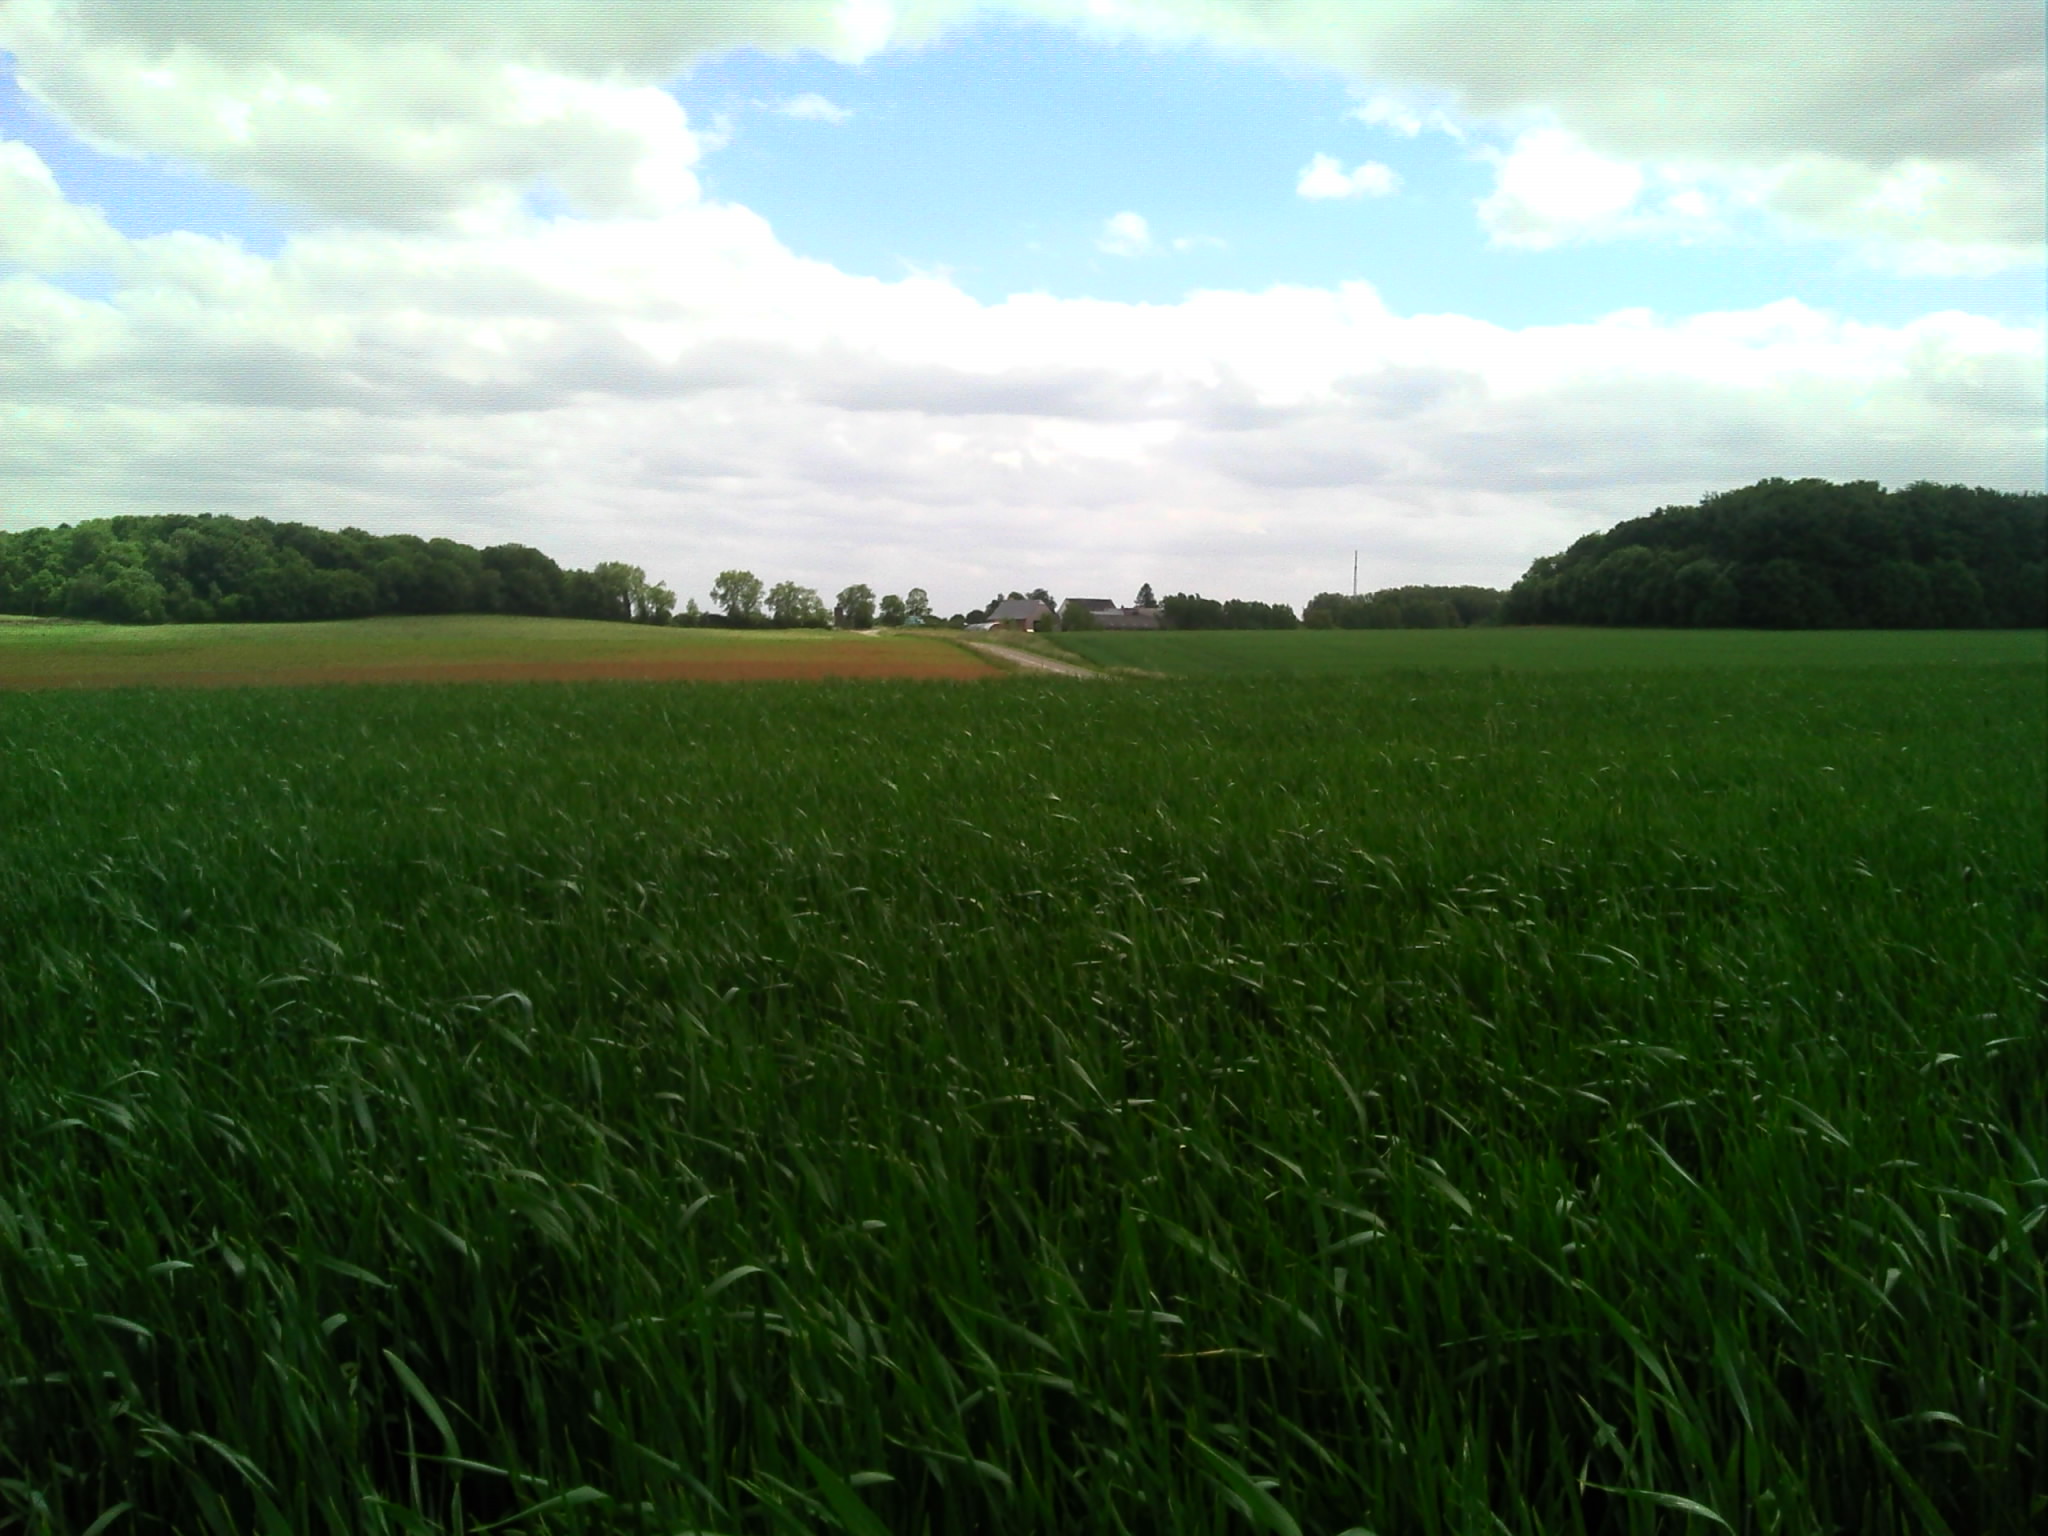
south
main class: Cropland
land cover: Common wheat
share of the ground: > 75 %
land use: Agriculture (excluding fallow land and kitchen gardens)
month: June
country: BE
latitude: 50.4914
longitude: 4.6540
